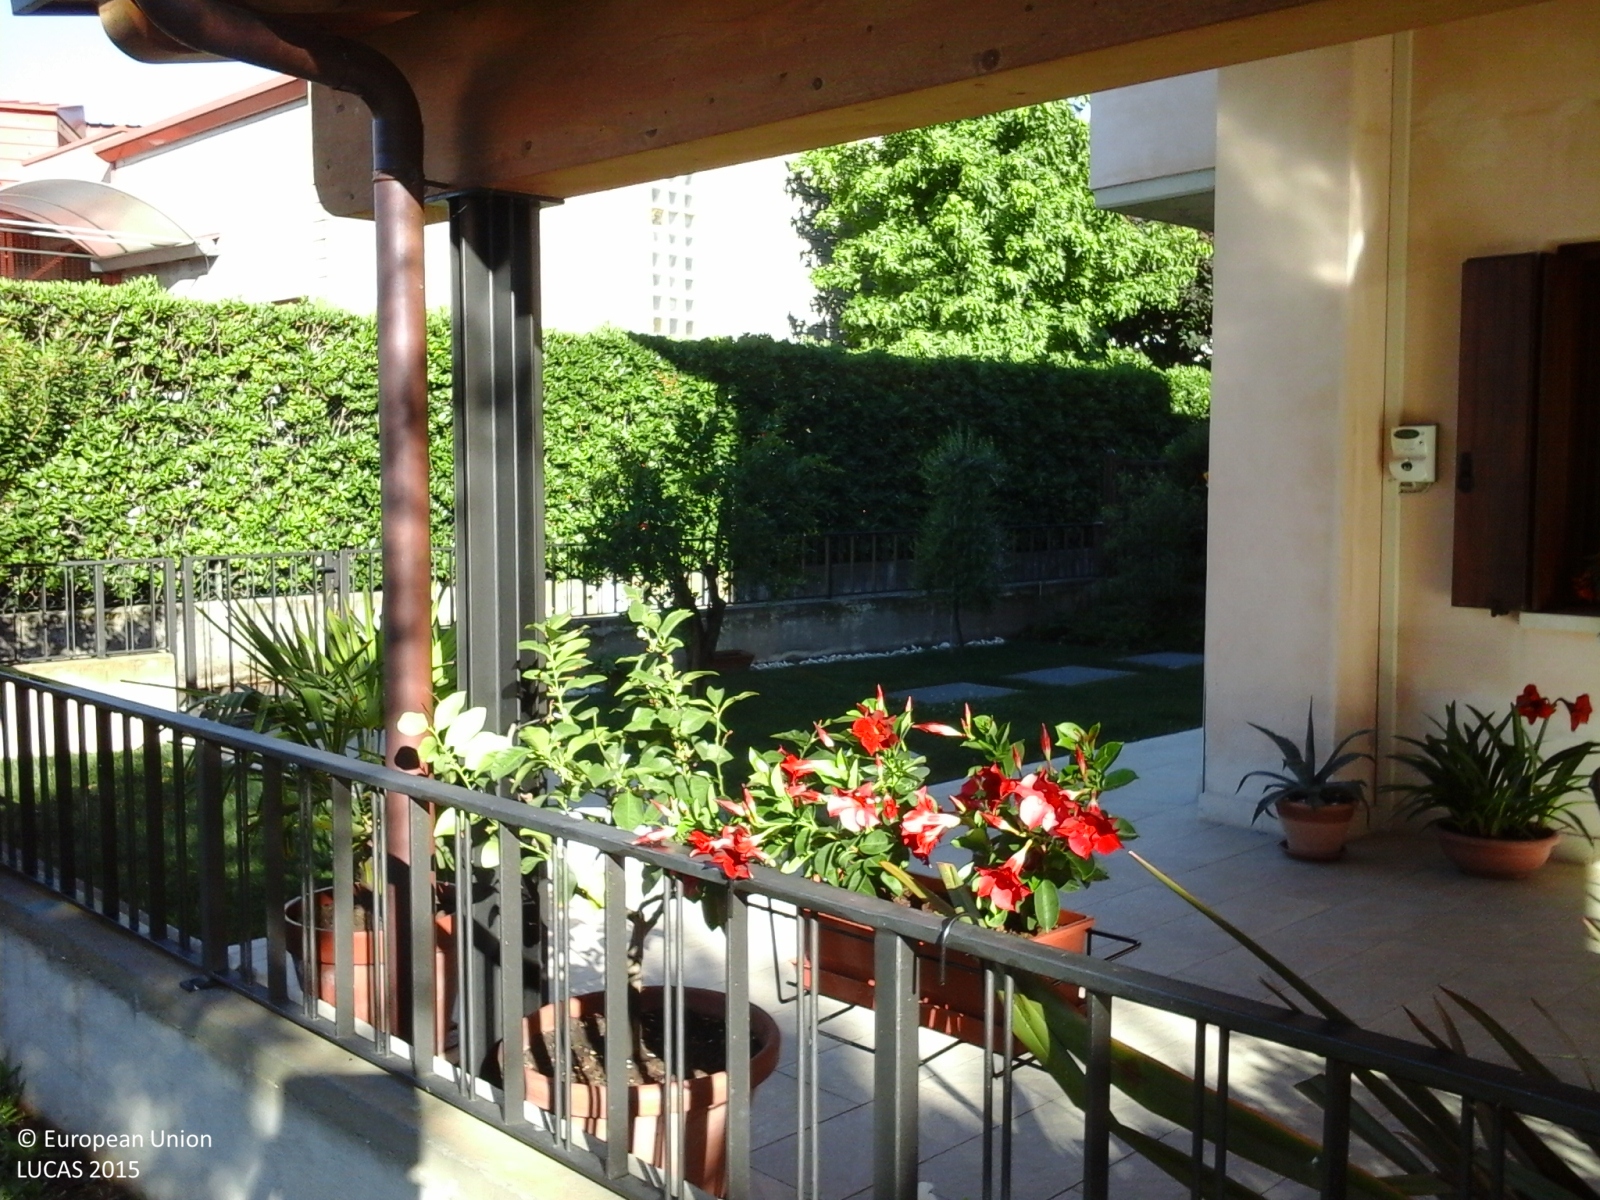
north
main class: Grassland
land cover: Grassland with sparse tree/shrub cover
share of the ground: > 75 %
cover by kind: herbaceous plants 95 %, broadleaved forest trees 5 %
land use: Amenities, museums, leisure
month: June
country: IT
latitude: 45.7966
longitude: 11.7342
